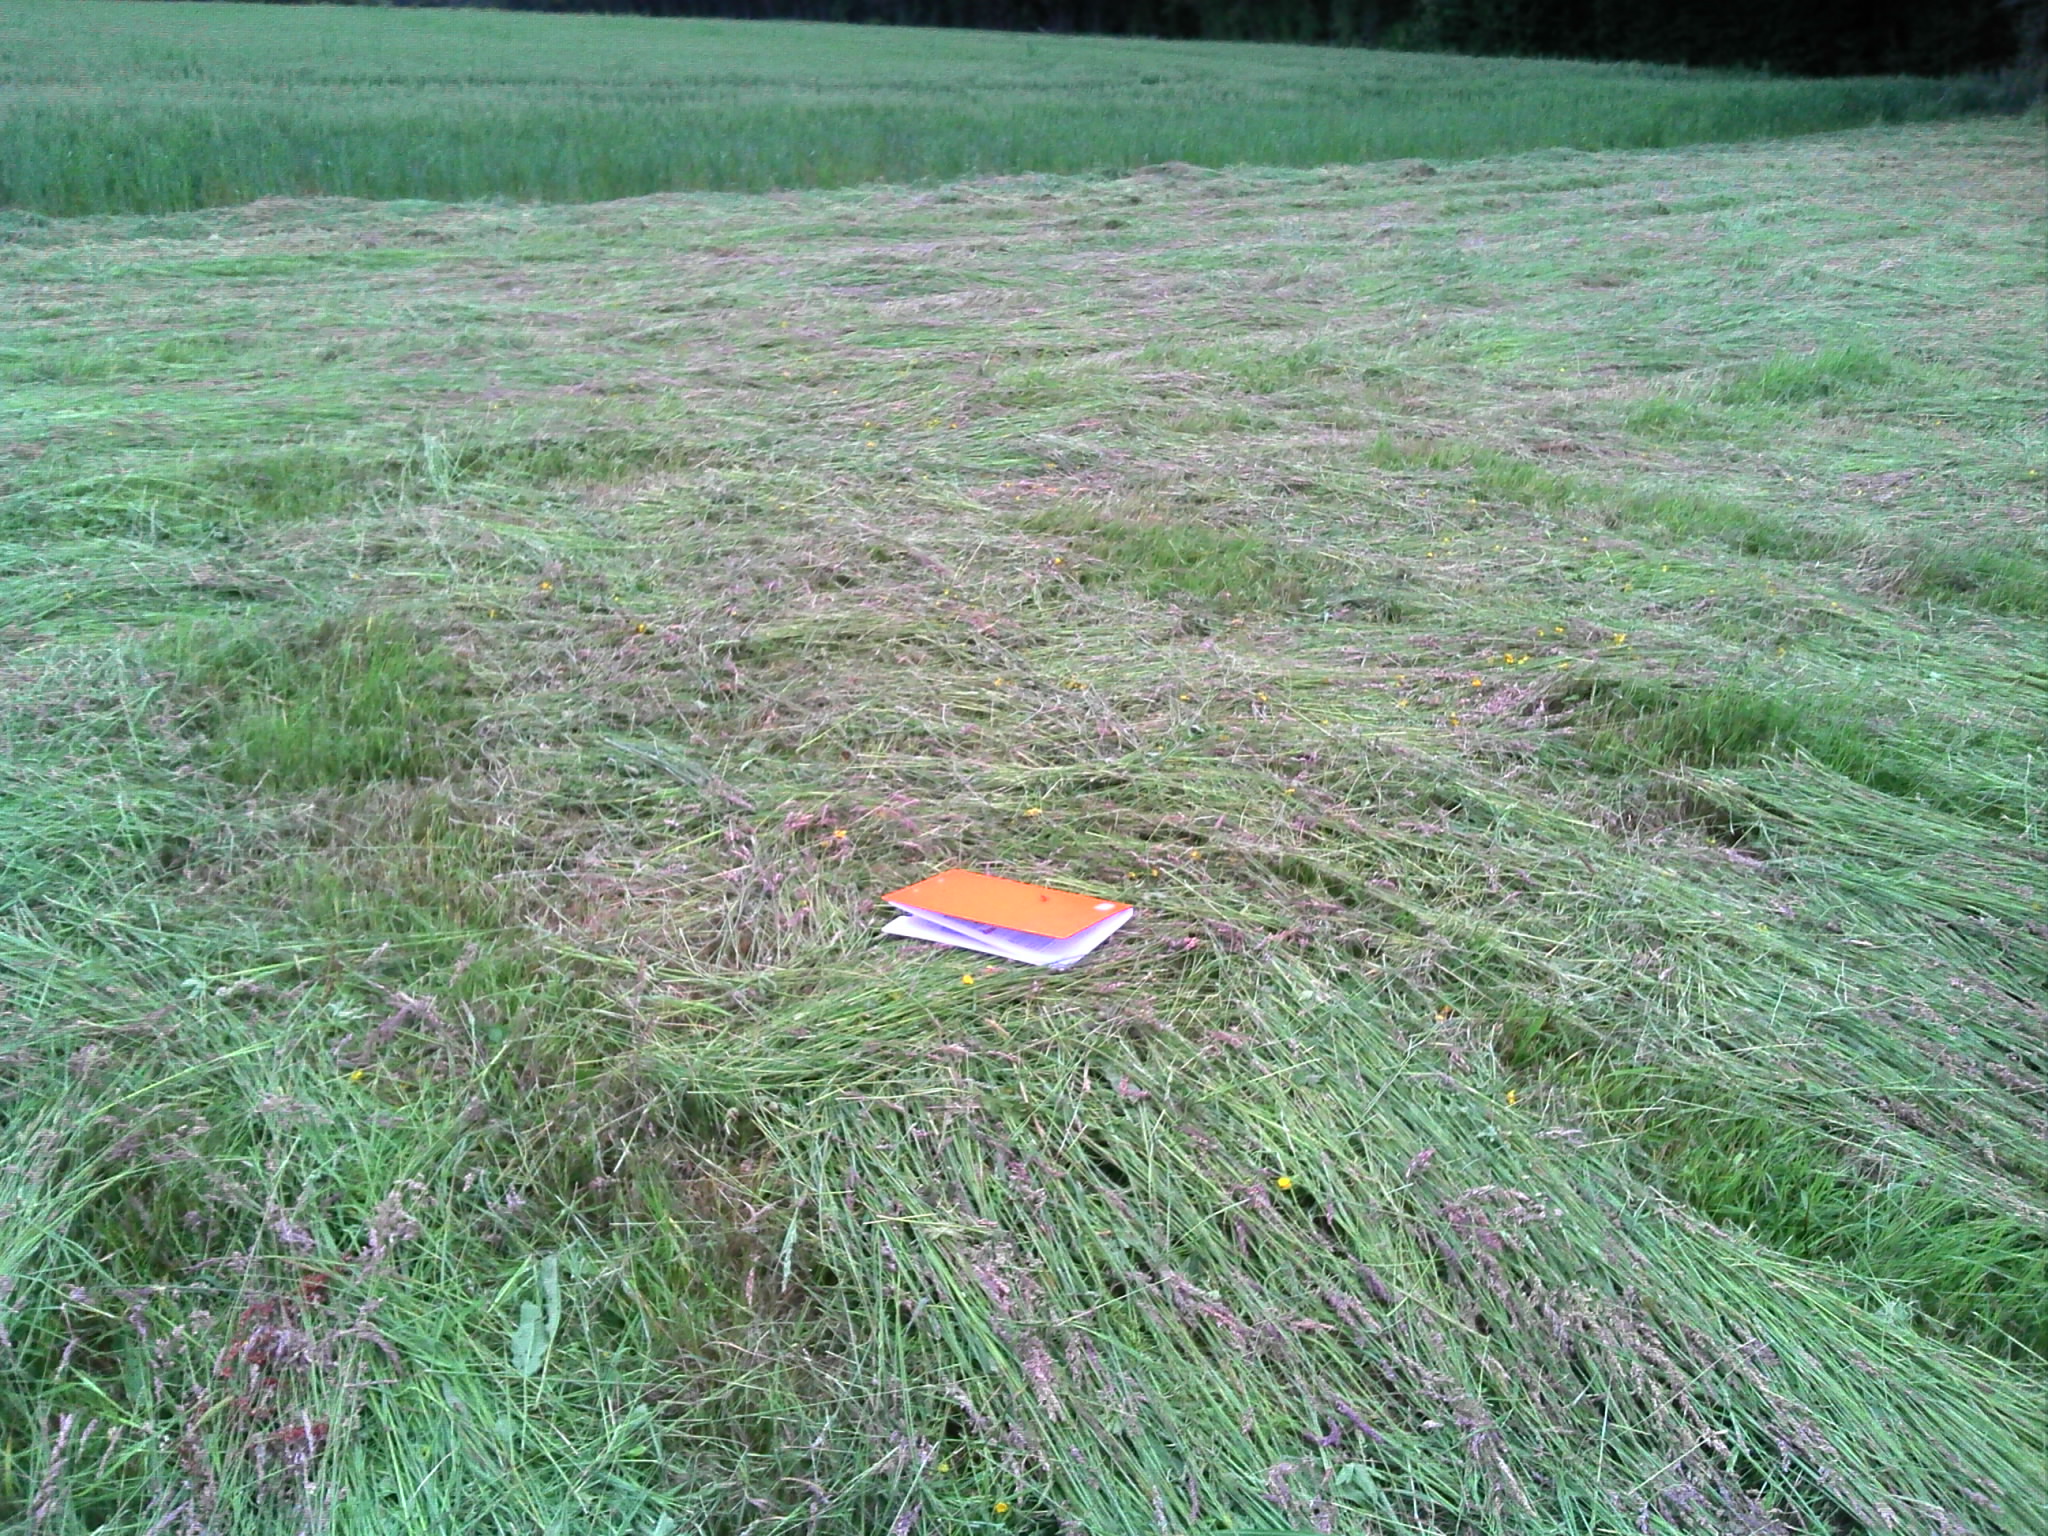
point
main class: Grassland
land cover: Grassland without tree/shrub cover
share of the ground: > 75 %
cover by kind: herbaceous plants 100 %
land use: Agriculture (excluding fallow land and kitchen gardens)
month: May
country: FR
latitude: 47.4132
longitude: 2.8503
